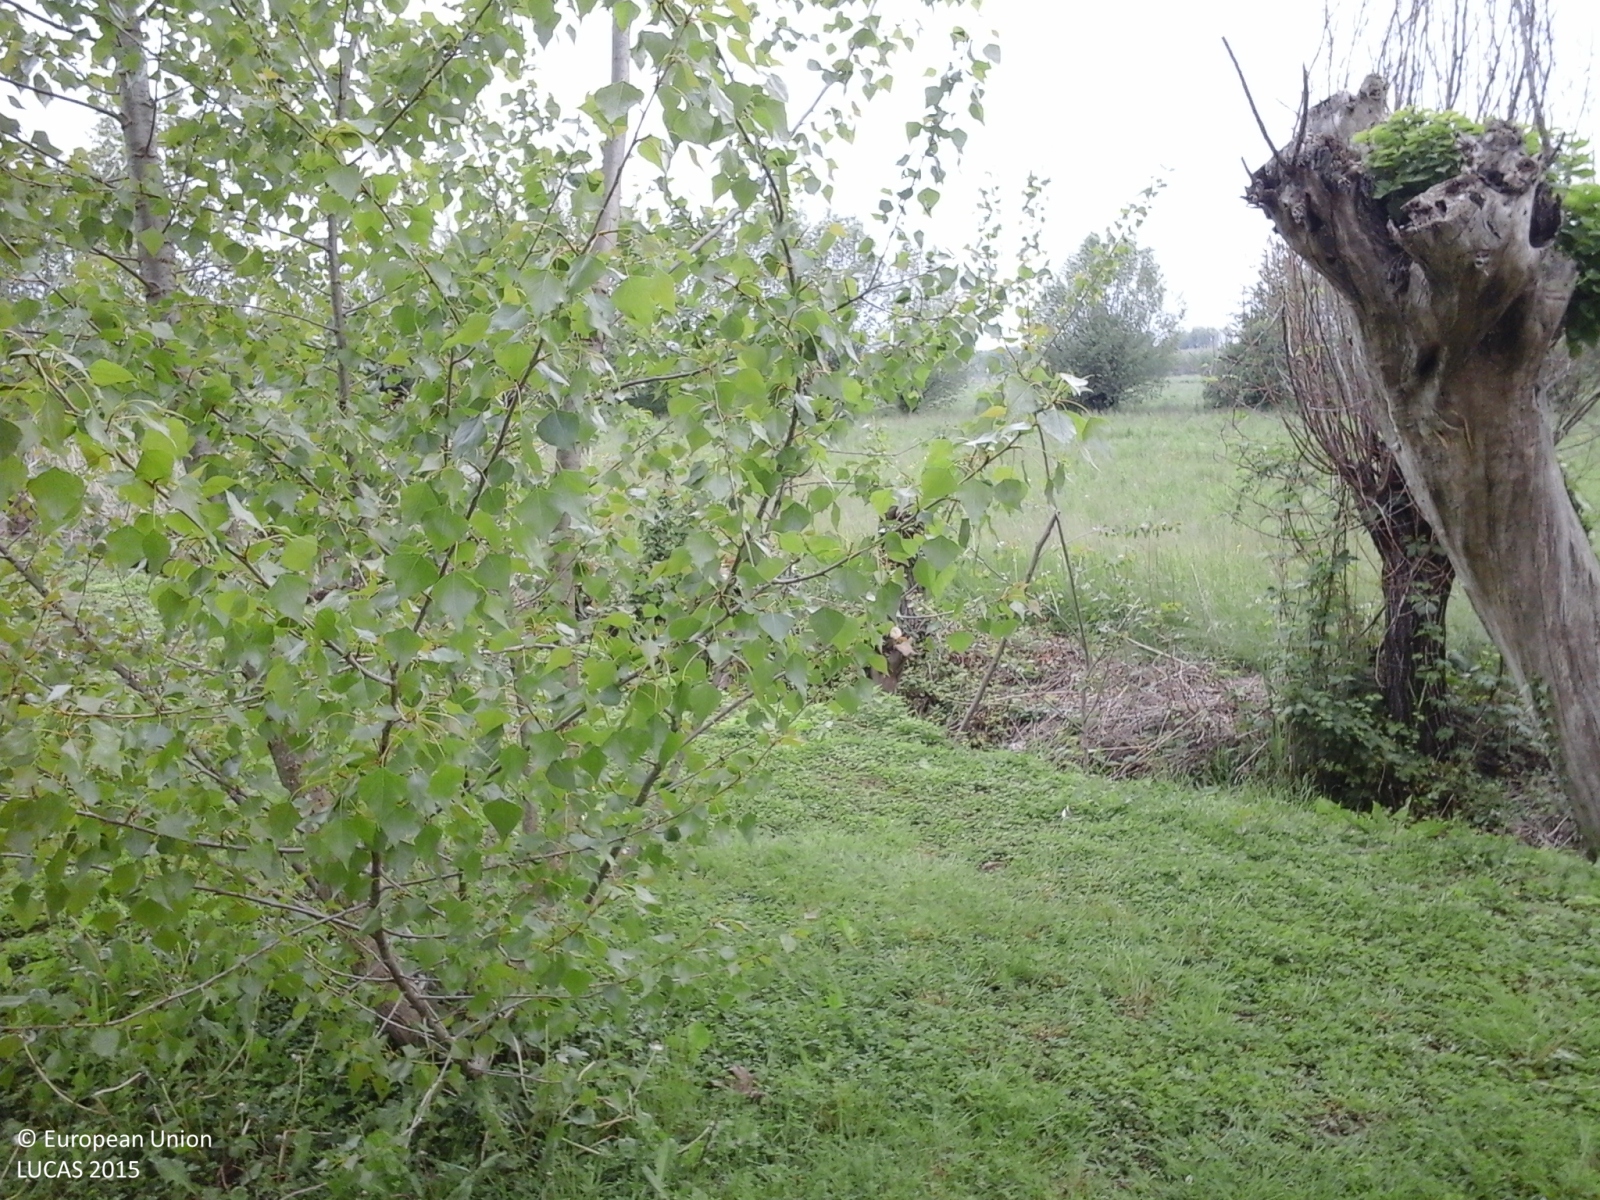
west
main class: Woodland
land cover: Broadleaved woodland
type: mesophytic deciduous forest
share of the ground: > 75 %
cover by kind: herbaceous plants 60 %, broadleaved forest trees 40 %
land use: Residential
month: May
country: IT
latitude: 45.5804
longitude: 11.7274
